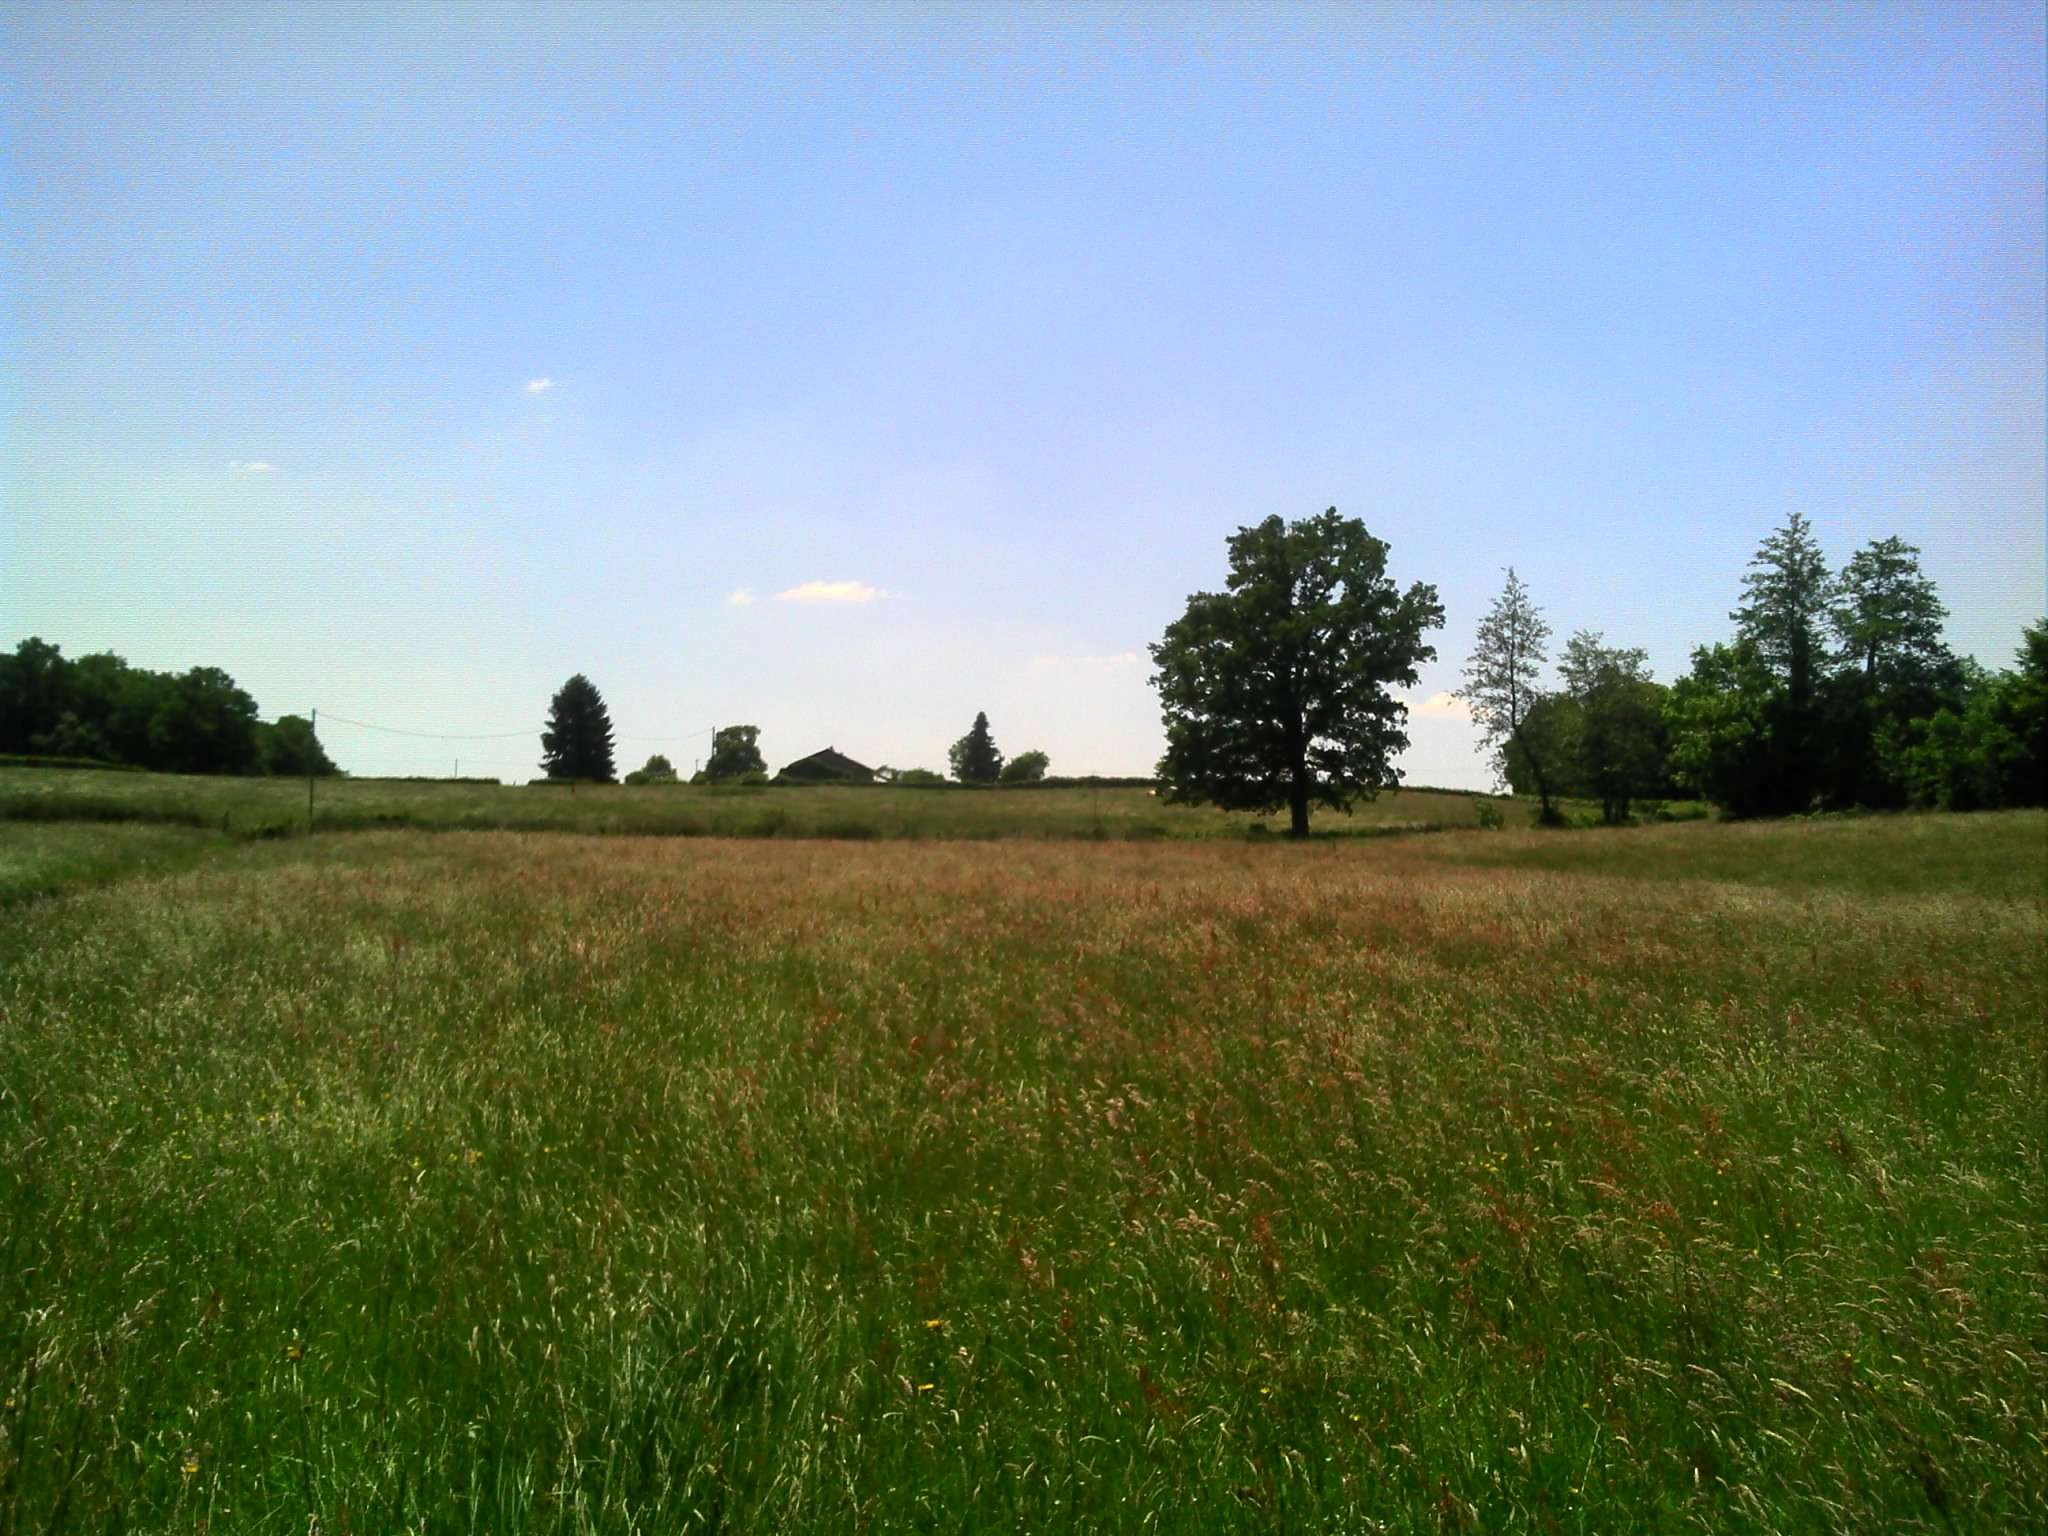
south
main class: Grassland
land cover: Grassland without tree/shrub cover
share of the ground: > 75 %
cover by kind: herbaceous plants 100 %
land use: Agriculture (excluding fallow land and kitchen gardens)
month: May
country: FR
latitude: 46.5115
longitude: 5.1409
